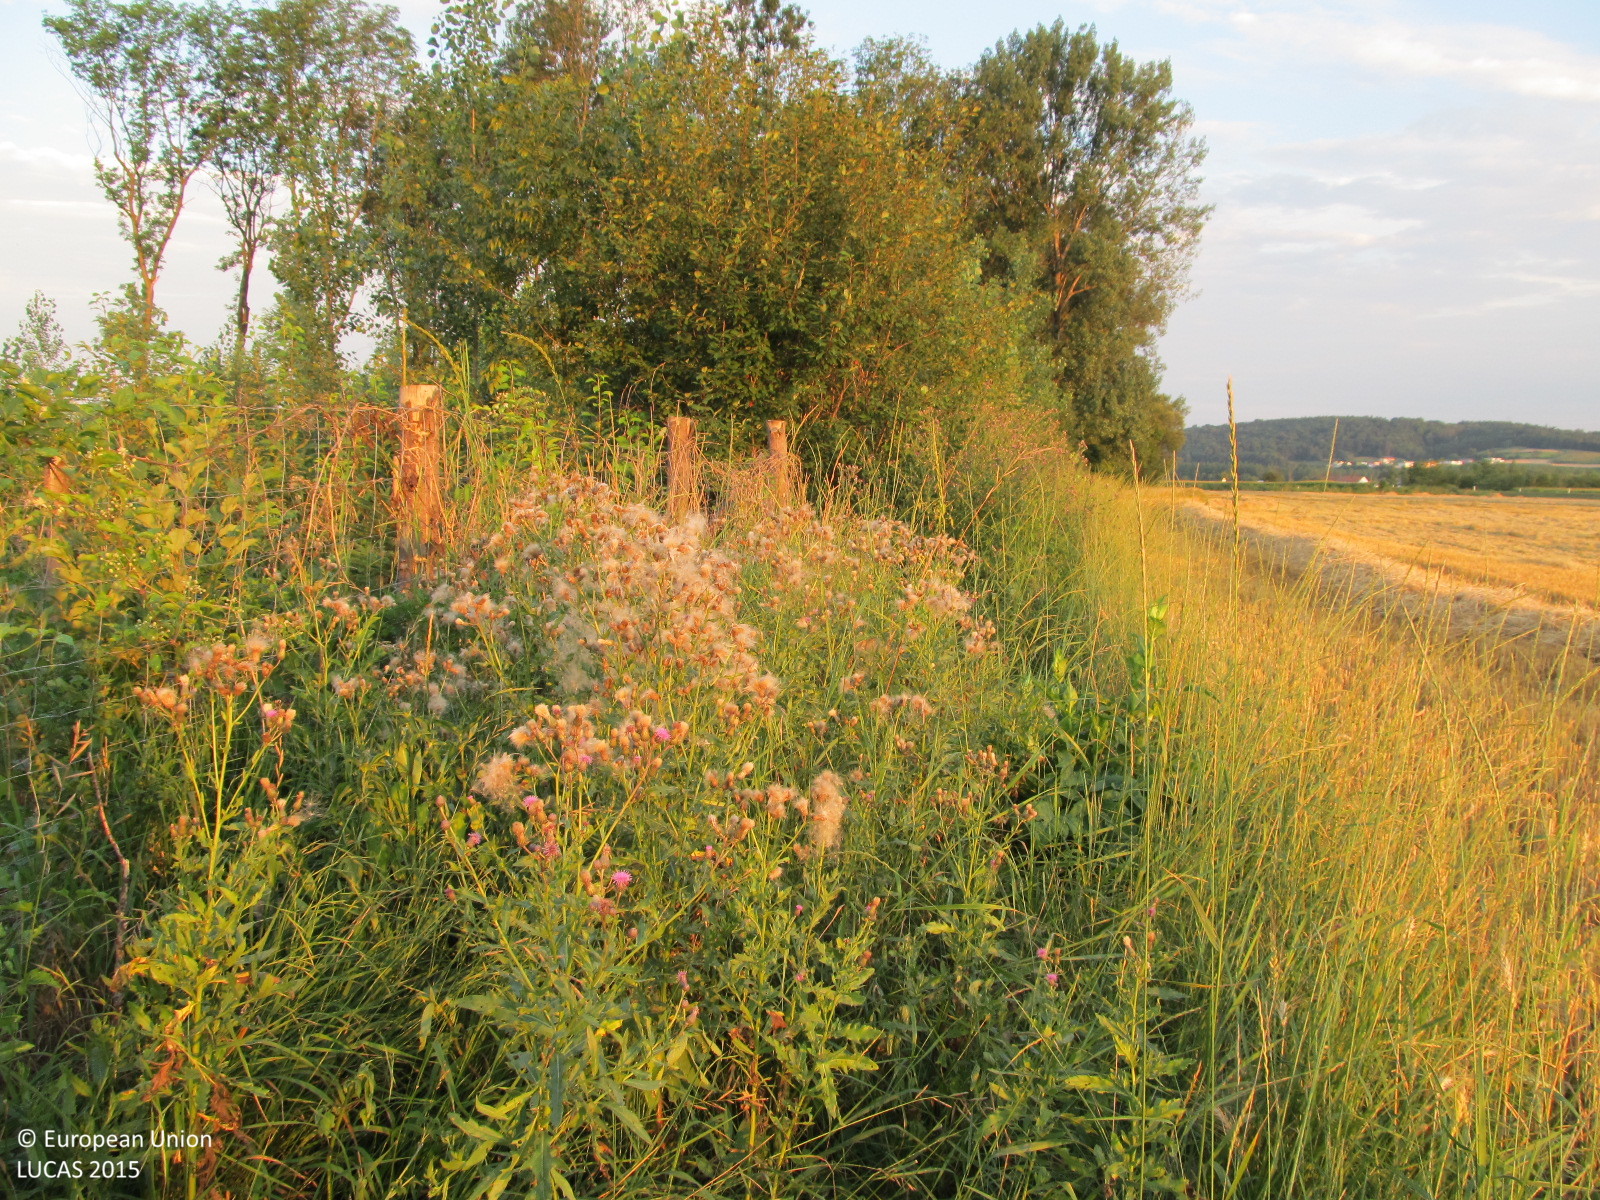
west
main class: Shrubland
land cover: Shrubland with sparse tree cover
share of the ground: > 75 %
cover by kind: shrubs 85 %, coniferous forest trees 5 %, herbaceous plants 5 %, unconsolidated bare surface 5 %
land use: Forestry
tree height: < 5 m
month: July
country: AT
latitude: 48.1956
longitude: 15.4778
